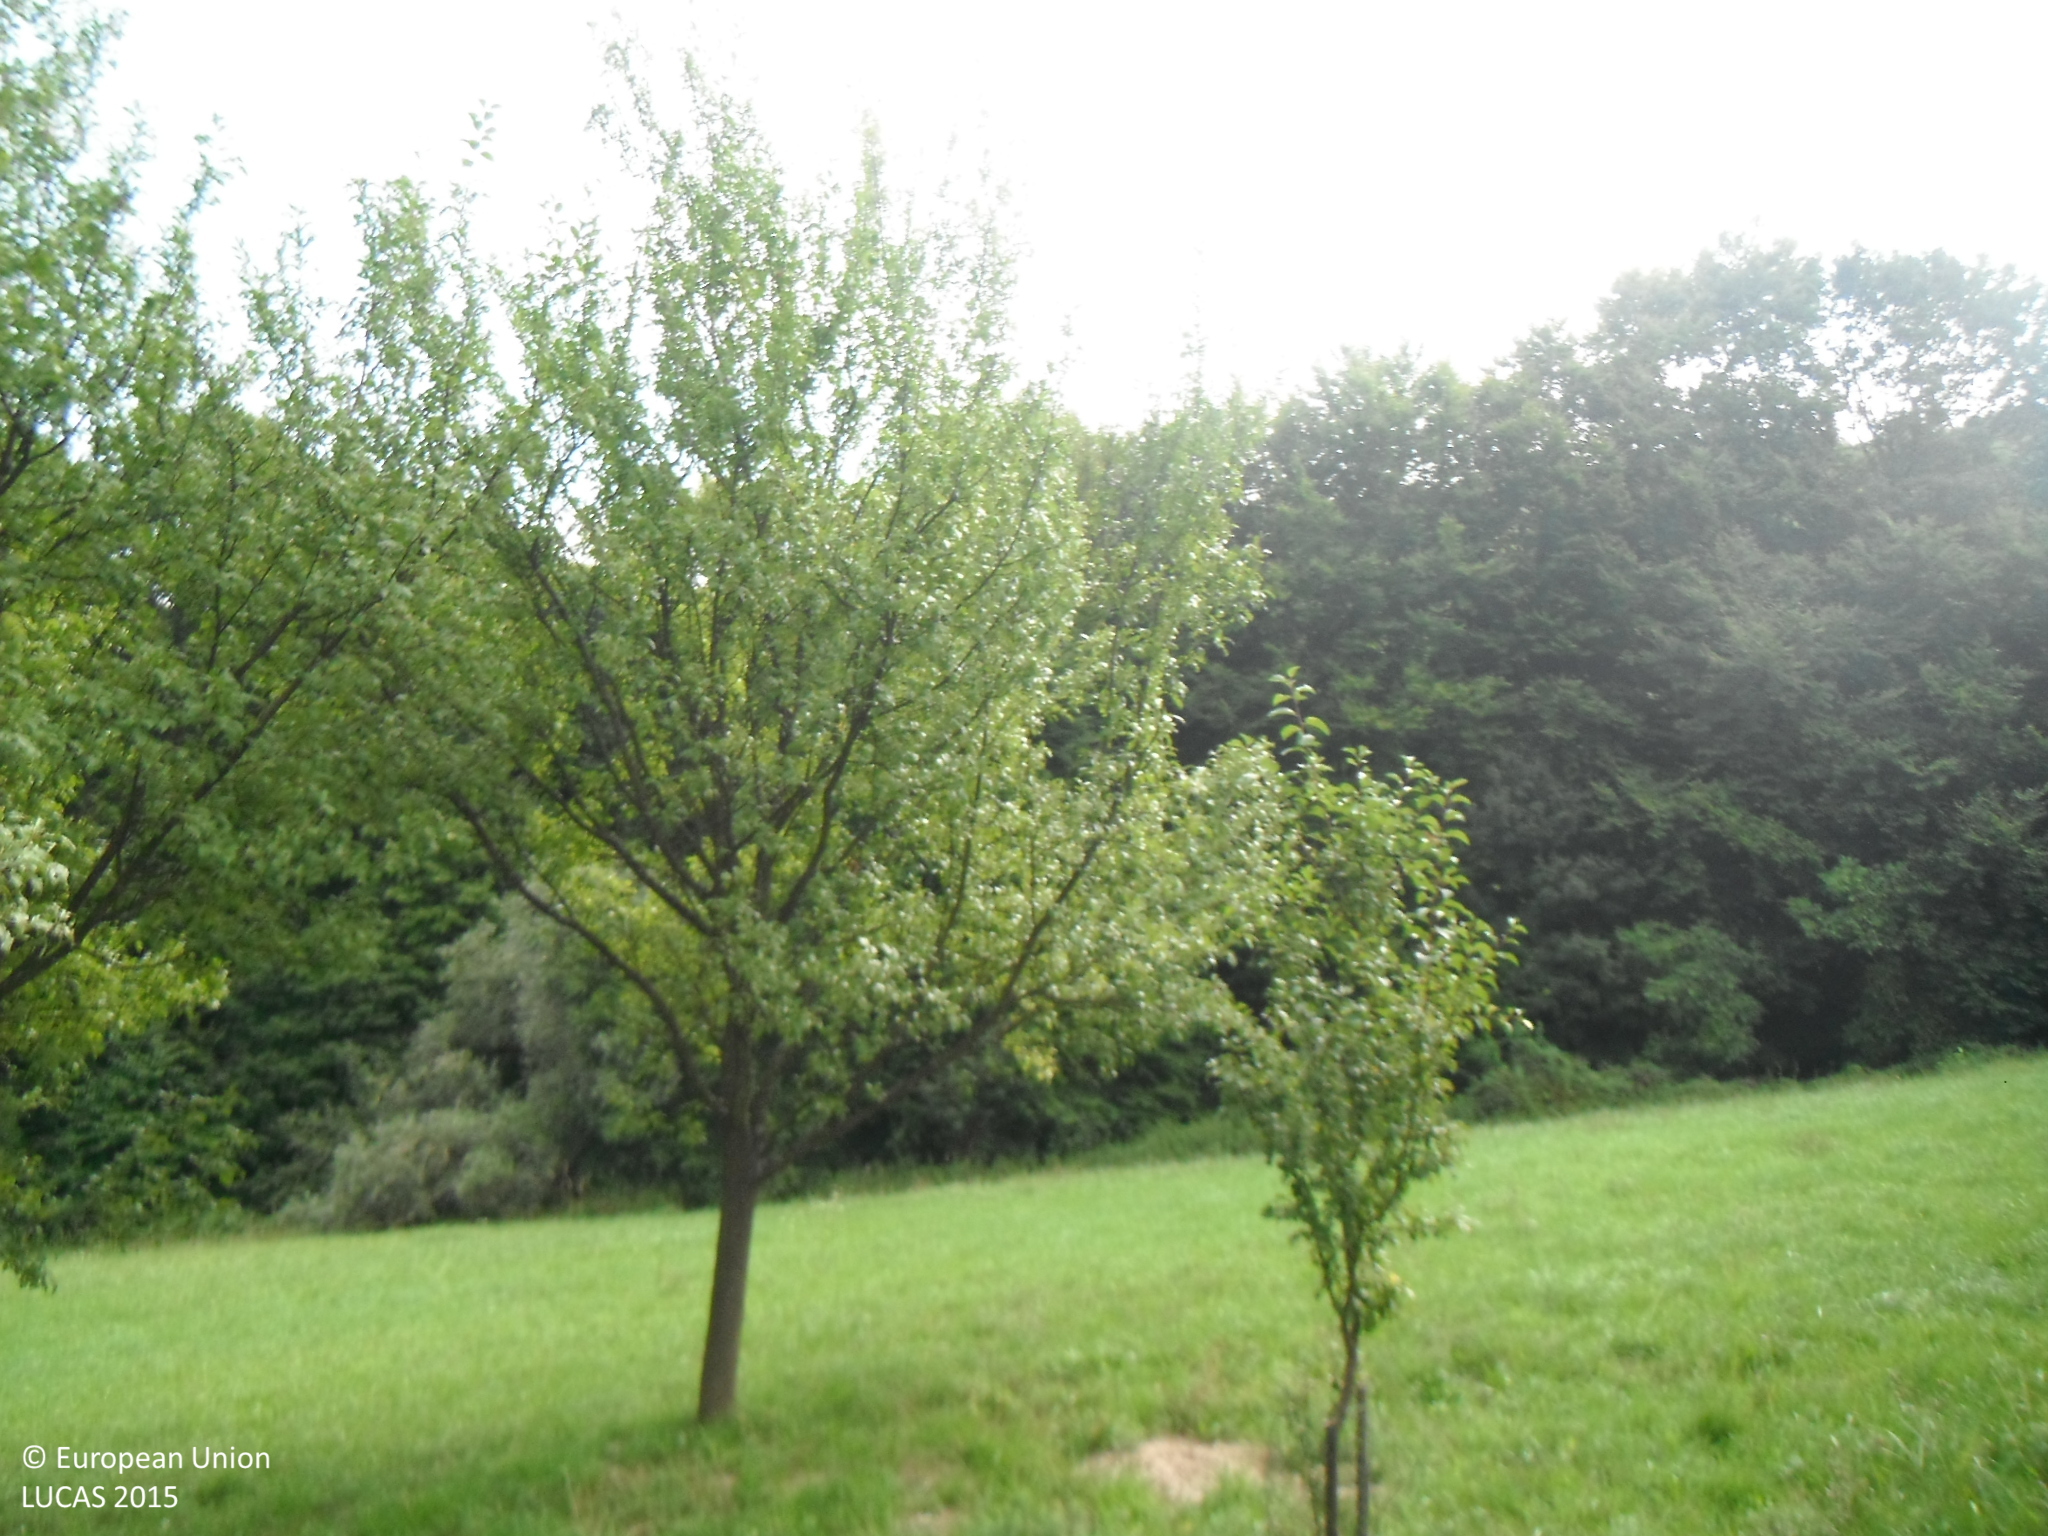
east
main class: Cropland
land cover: Other fruit trees and berries
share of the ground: 50 - 75 %
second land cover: Grassland without tree/shrub cover
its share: > 75 %
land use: Kitchen garden
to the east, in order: Other fruit trees and berries; Grassland without tree/shrub cover; Broadleaved woodland; Shrubland with sparse tree cover; Pine dominated mixed woodland; Broadleaved woodland; Tracks; Broadleaved woodland
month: September
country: SK
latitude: 48.7193
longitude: 17.6098
